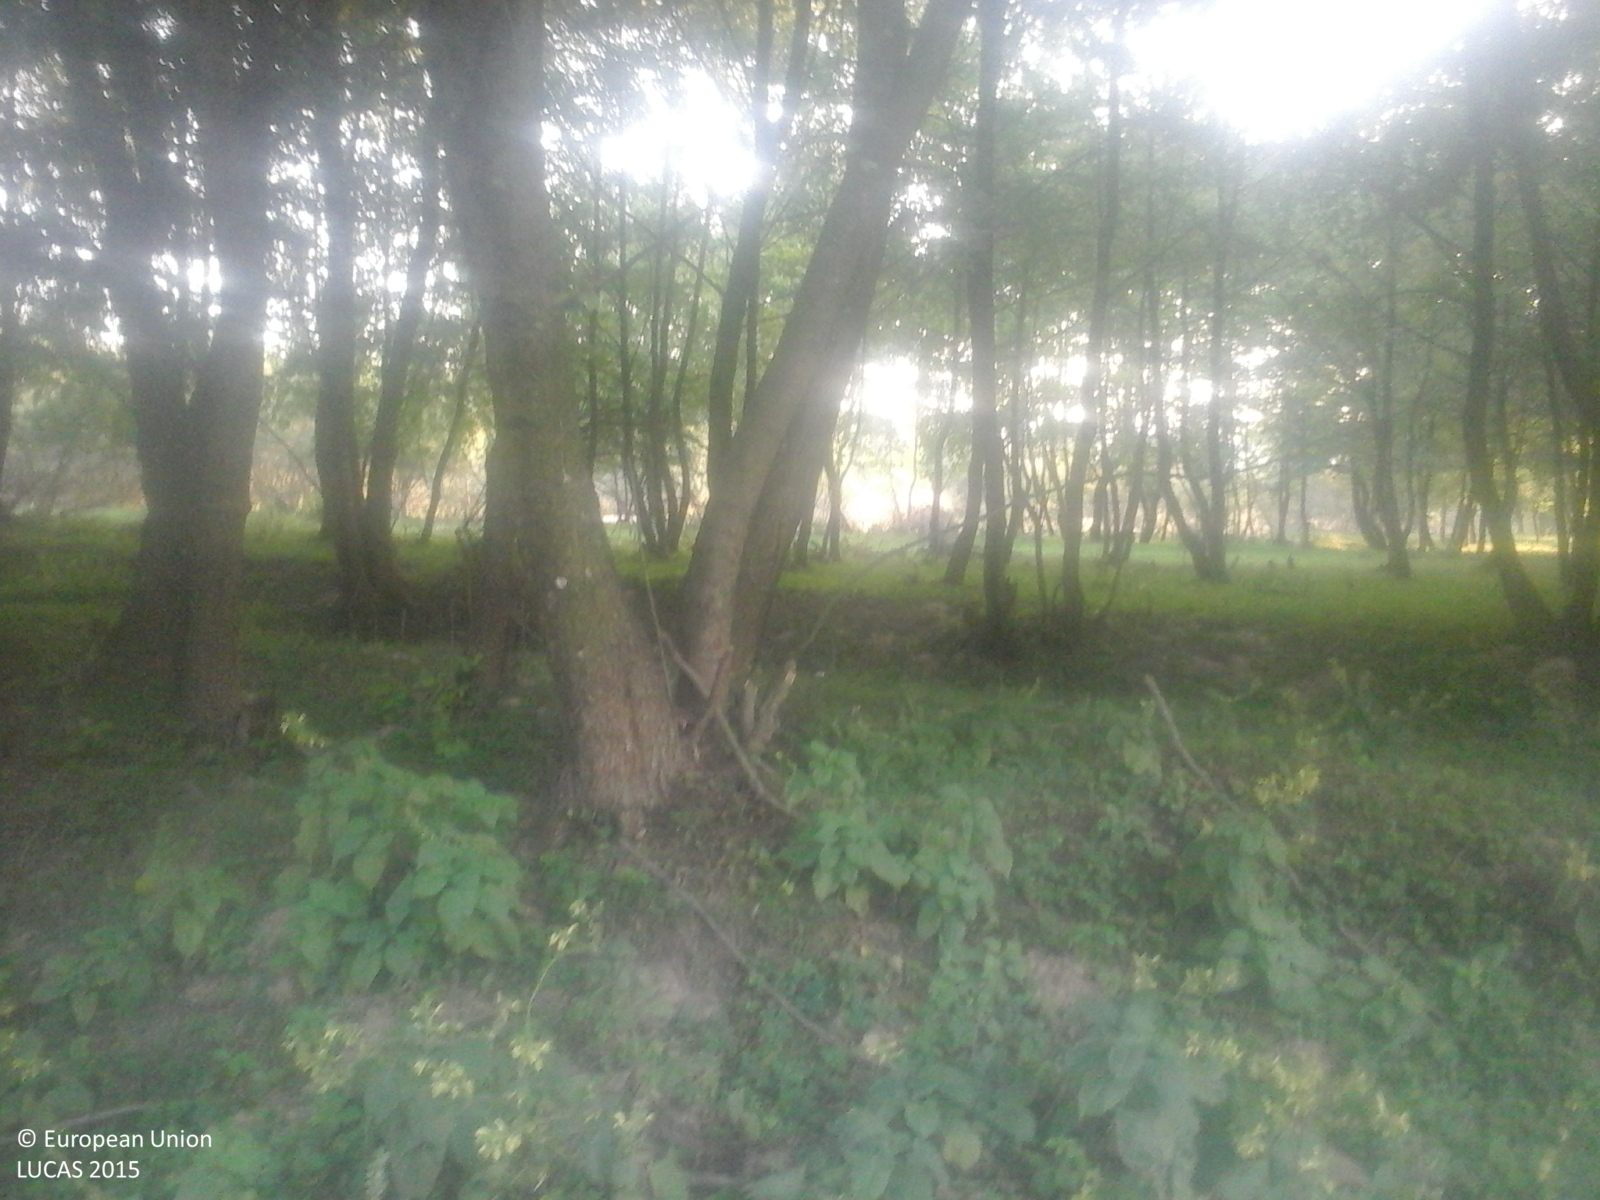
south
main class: Grassland
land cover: Grassland without tree/shrub cover
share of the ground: > 75 %
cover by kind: herbaceous plants 100 %
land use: Agriculture (excluding fallow land and kitchen gardens)
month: September
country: RO
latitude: 46.6259
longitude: 22.4192
